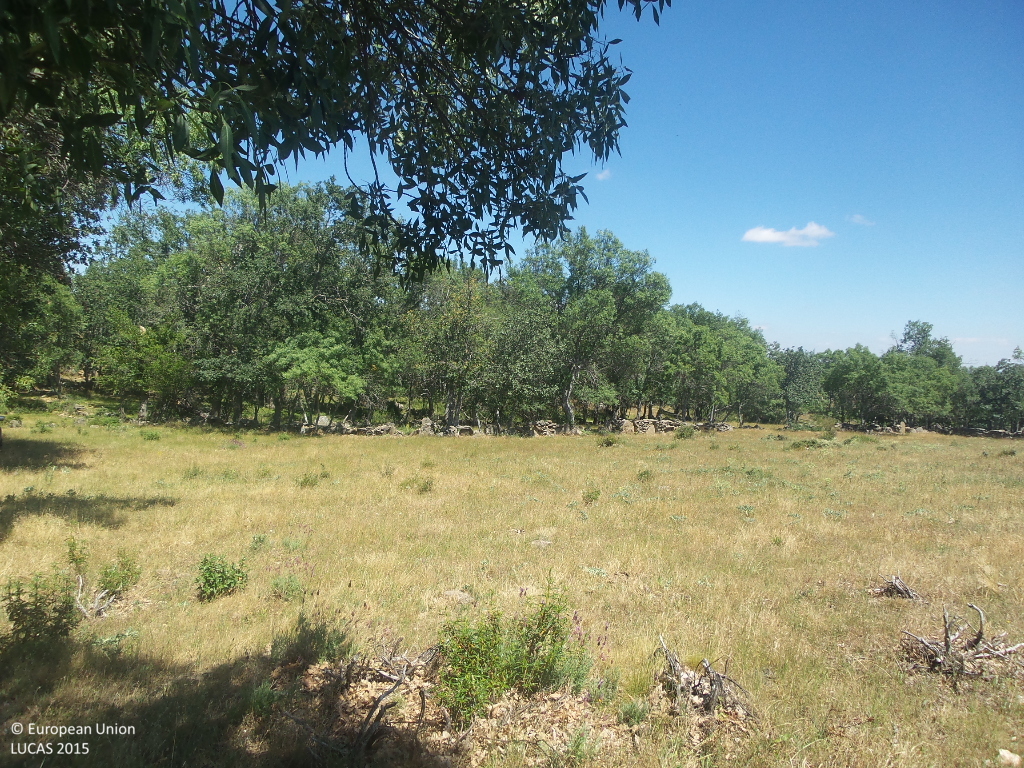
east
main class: Woodland
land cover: Broadleaved woodland
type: thermophilous deciduous forest
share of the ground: 50 - 75 %
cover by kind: broadleaved forest trees 35 %, shrubs 35 %, herbaceous plants 30 %
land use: Agriculture (excluding fallow land and kitchen gardens)
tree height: > 5 m
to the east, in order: Broadleaved woodland; Grassland with sparse tree/shrub cover; Tracks; Grassland with sparse tree/shrub cover; Dry stone walls; Grassland with sparse tree/shrub cover; Dry stone walls; Broadleaved woodland; Dry stone walls; Broadleaved woodland; Dry stone walls; Broadleaved woodland; Dry stone walls; Grassland with sparse tree/shrub cover; Dry stone walls; Shrubland without tree cover
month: June
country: ES
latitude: 41.1076
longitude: -3.0771
